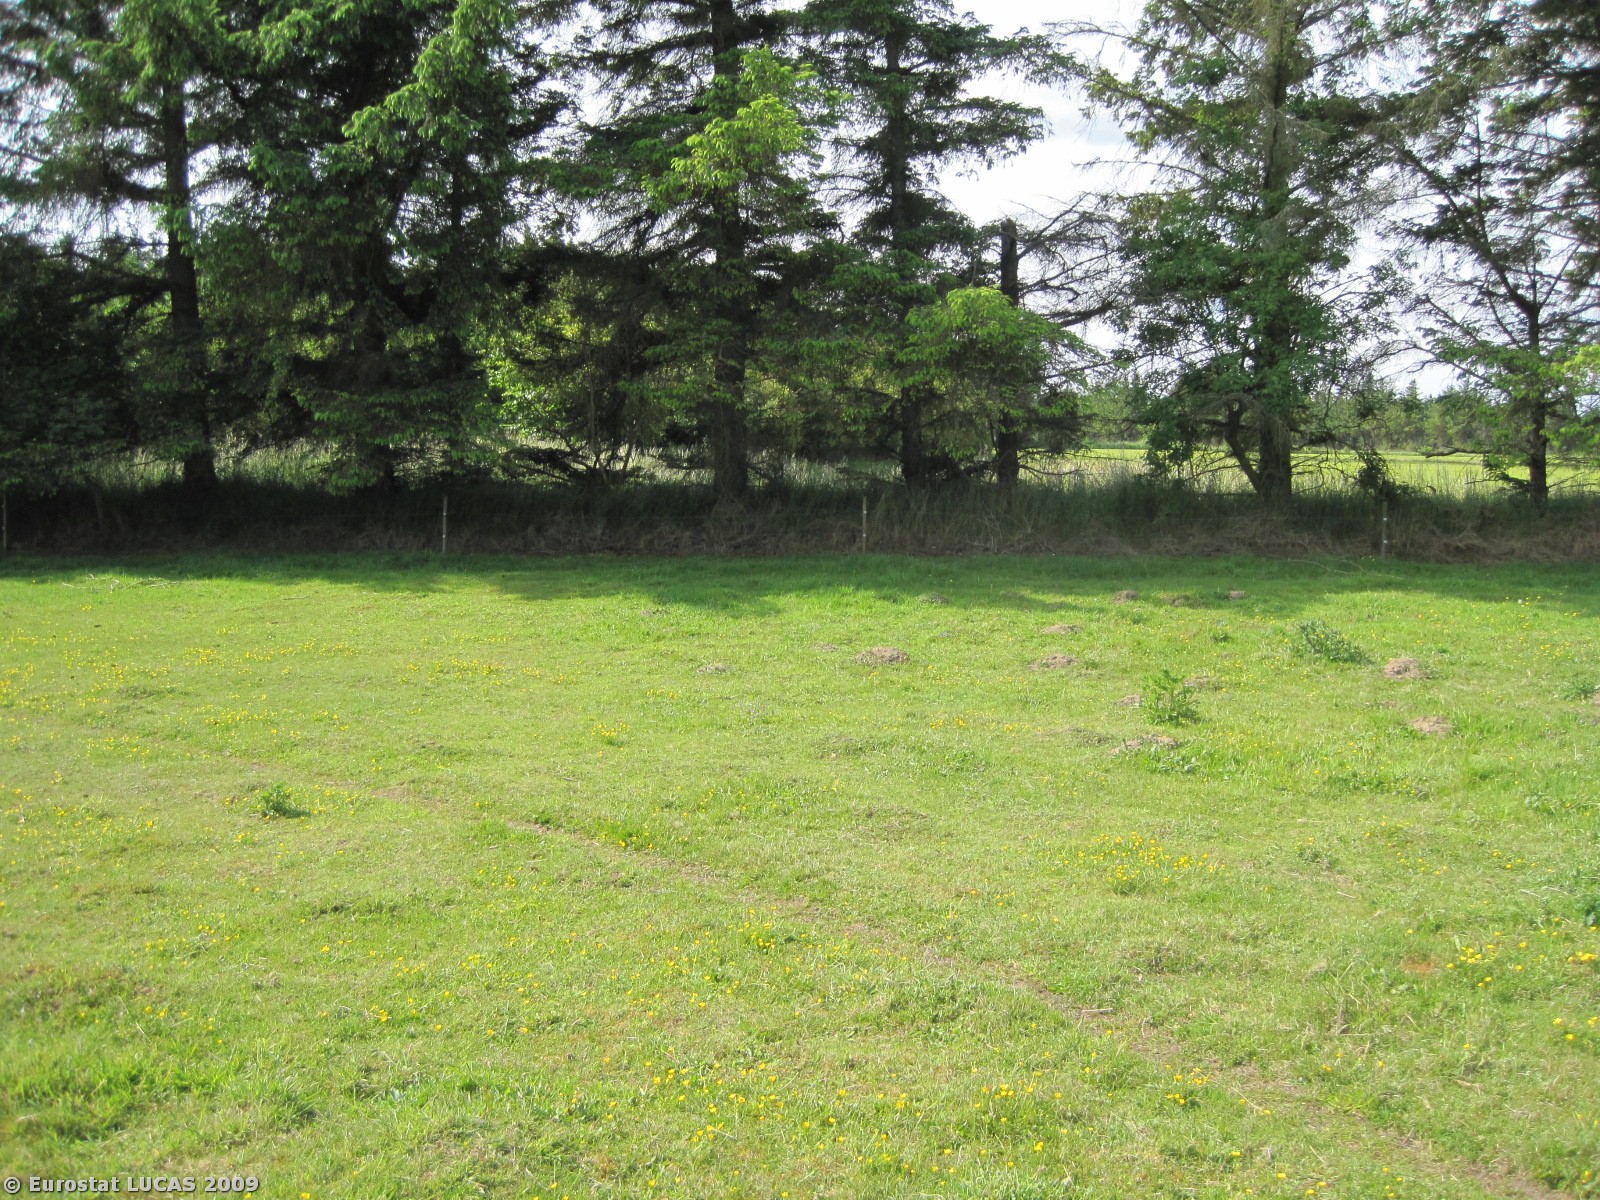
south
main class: Grassland
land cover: Grassland without tree/shrub cover
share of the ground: > 75 %
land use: Agriculture (excluding fallow land and kitchen gardens)
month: June
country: DK
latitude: 57.4280
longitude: 9.7839
